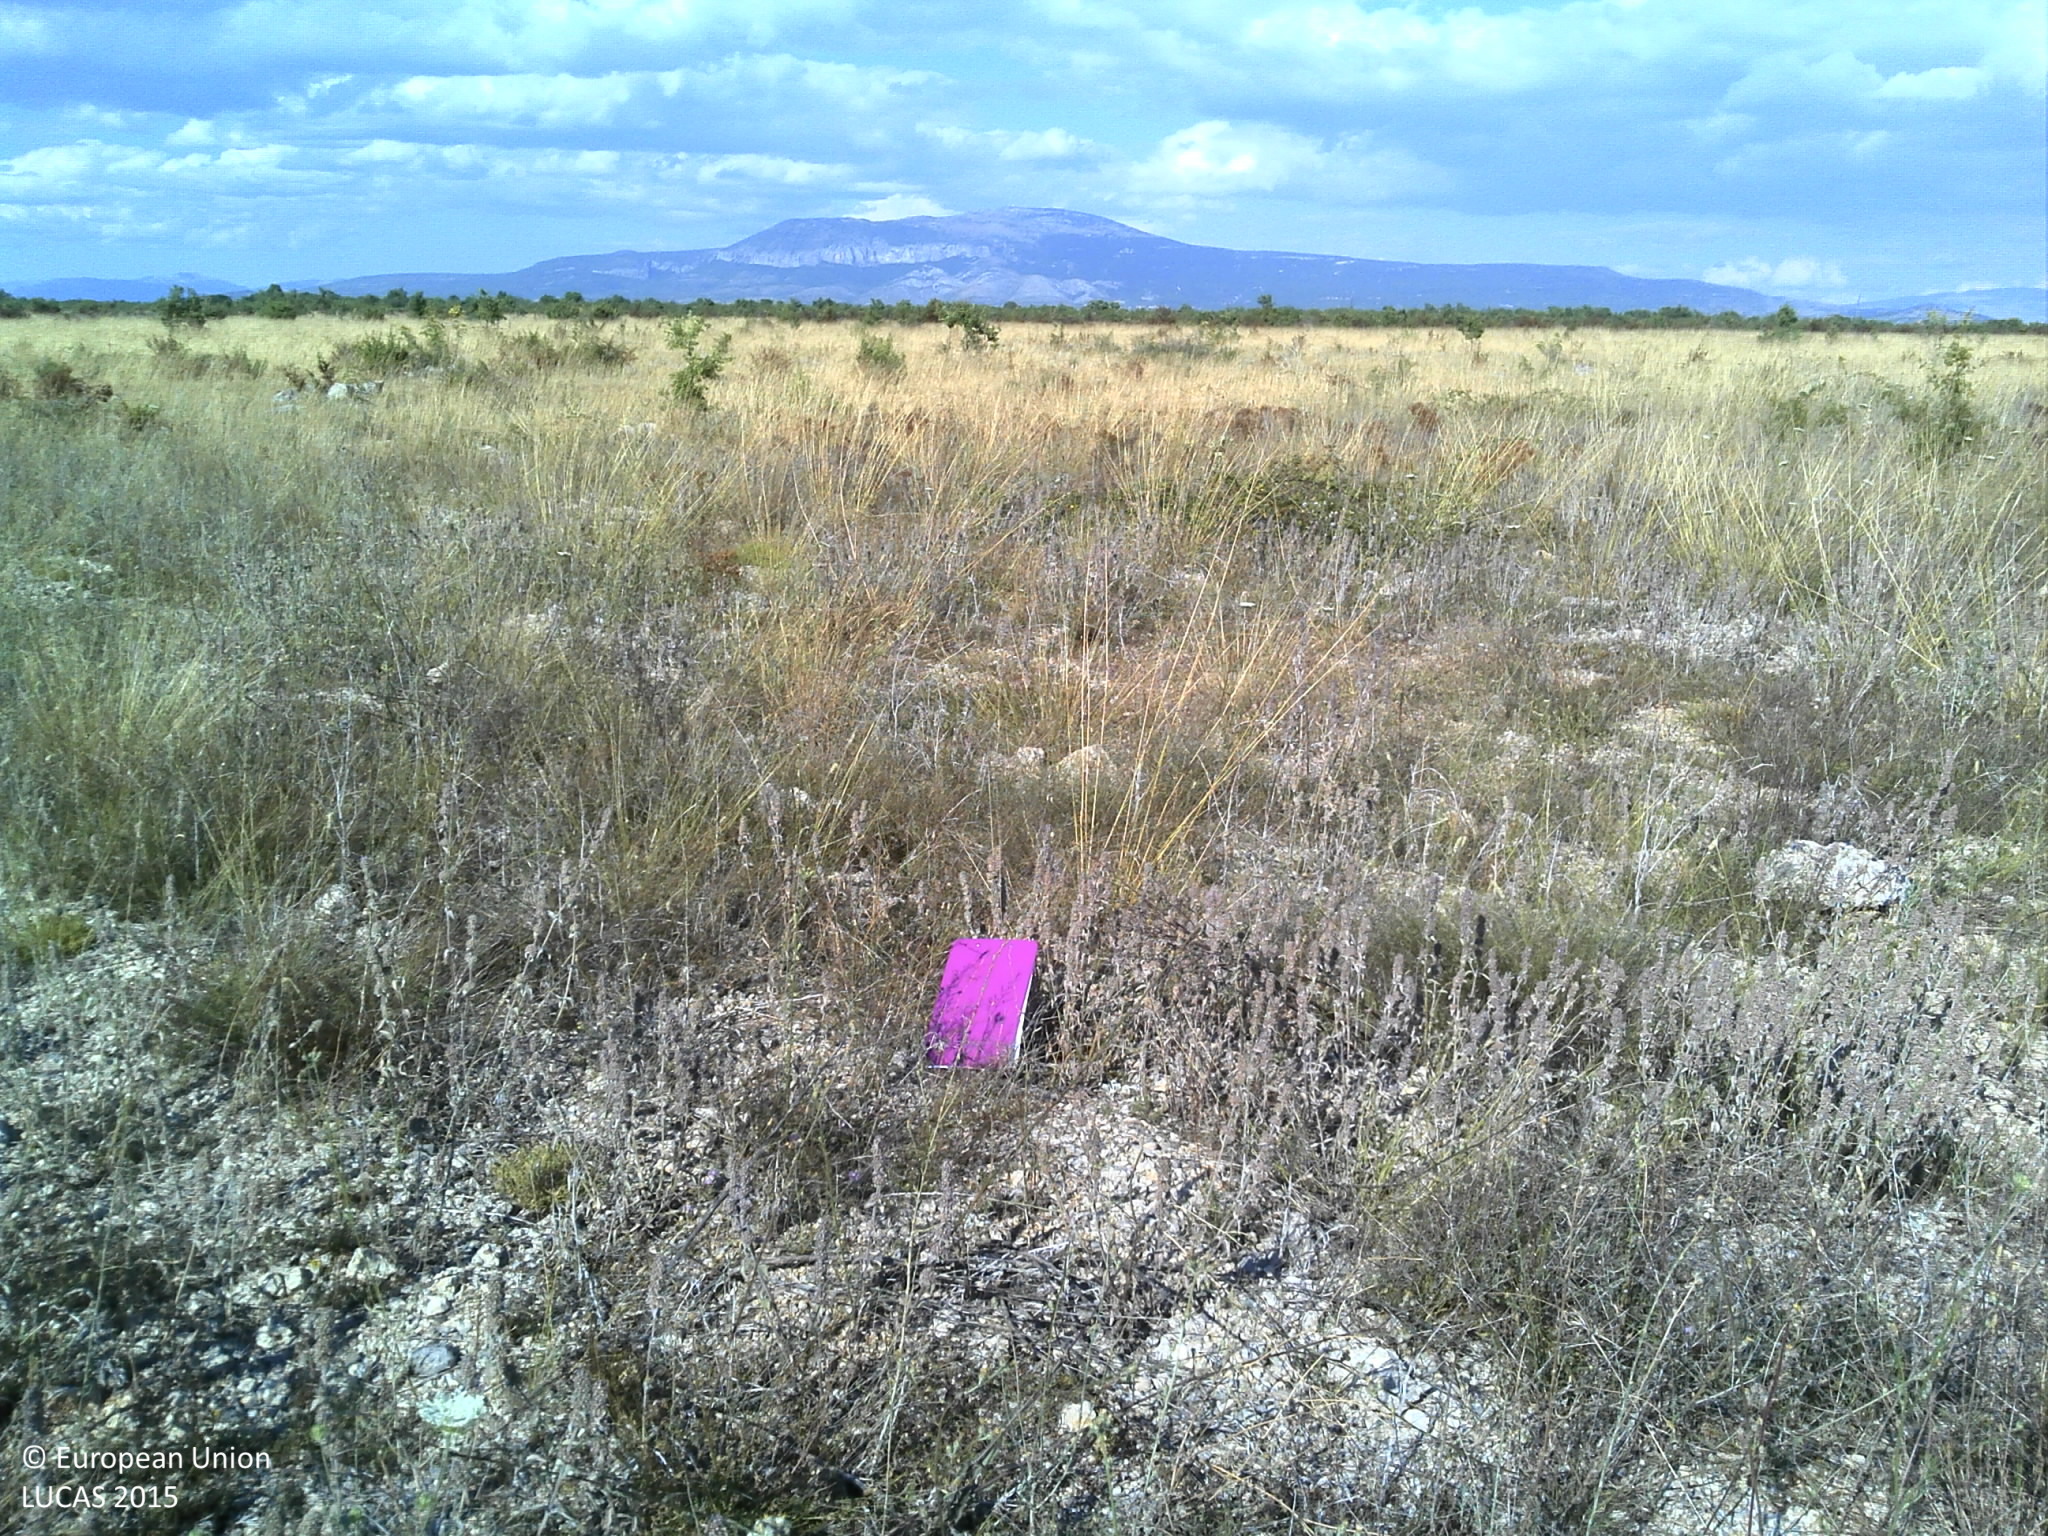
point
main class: Grassland
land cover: Grassland with sparse tree/shrub cover
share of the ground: 25 - 50 %
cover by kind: herbaceous plants 40 %, unconsolidated bare surface 30 %, consolidated bare surface 20 %, broadleaved forest trees 5 %, shrubs 5 %
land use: Abandoned areas
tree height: < 5 m
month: July
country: HR
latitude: 43.8679
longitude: 16.0267
